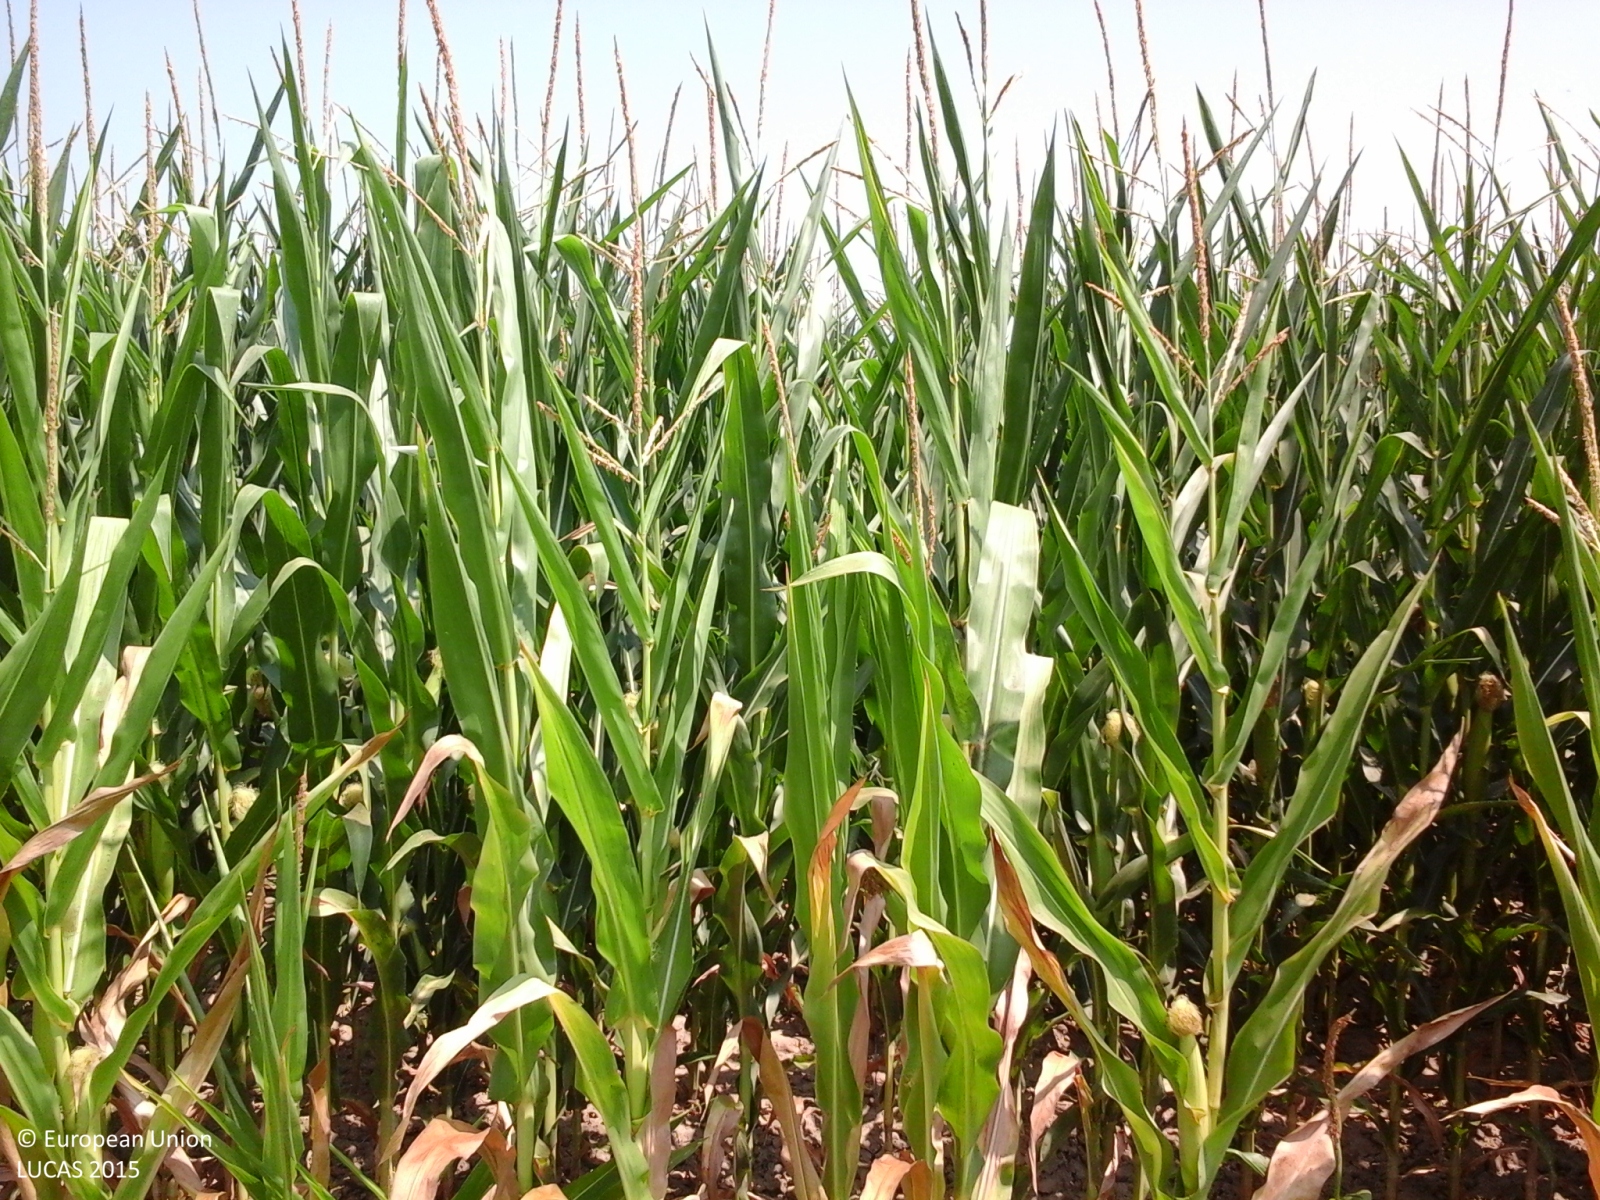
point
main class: Cropland
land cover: Maize
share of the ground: > 75 %
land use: Agriculture (excluding fallow land and kitchen gardens)
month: July
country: IT
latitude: 44.6261
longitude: 11.6477
